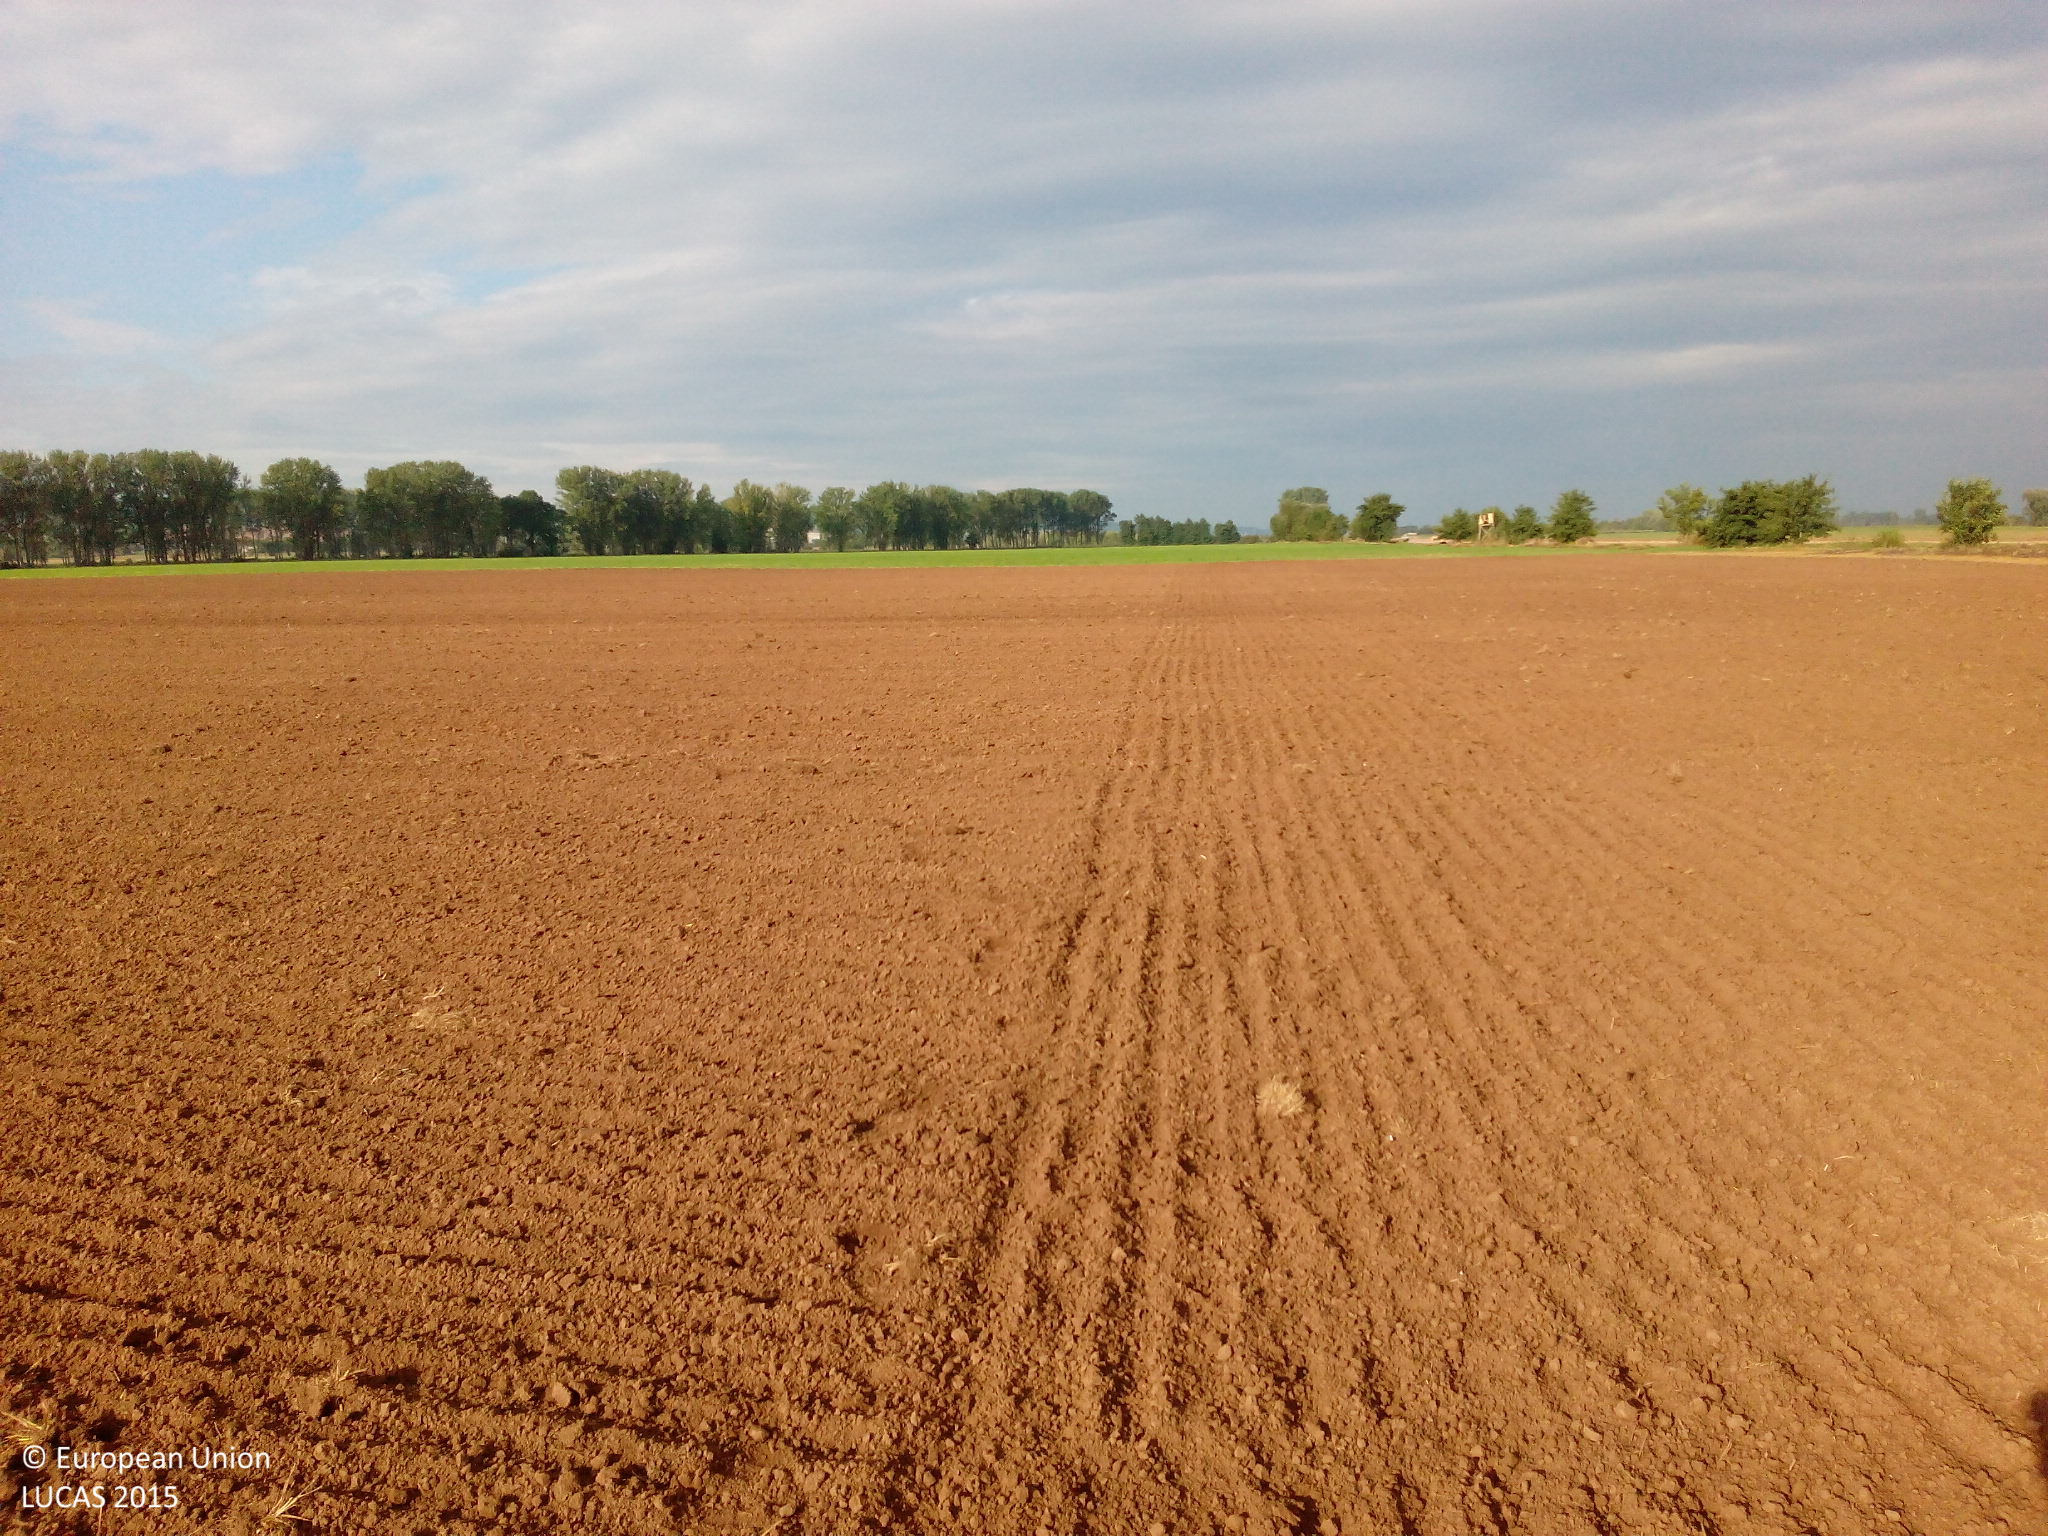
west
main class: Cropland
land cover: Barley
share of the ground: < 10 %
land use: Agriculture (excluding fallow land and kitchen gardens)
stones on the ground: < 10 %
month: September
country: DE
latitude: 51.4388
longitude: 10.9636
